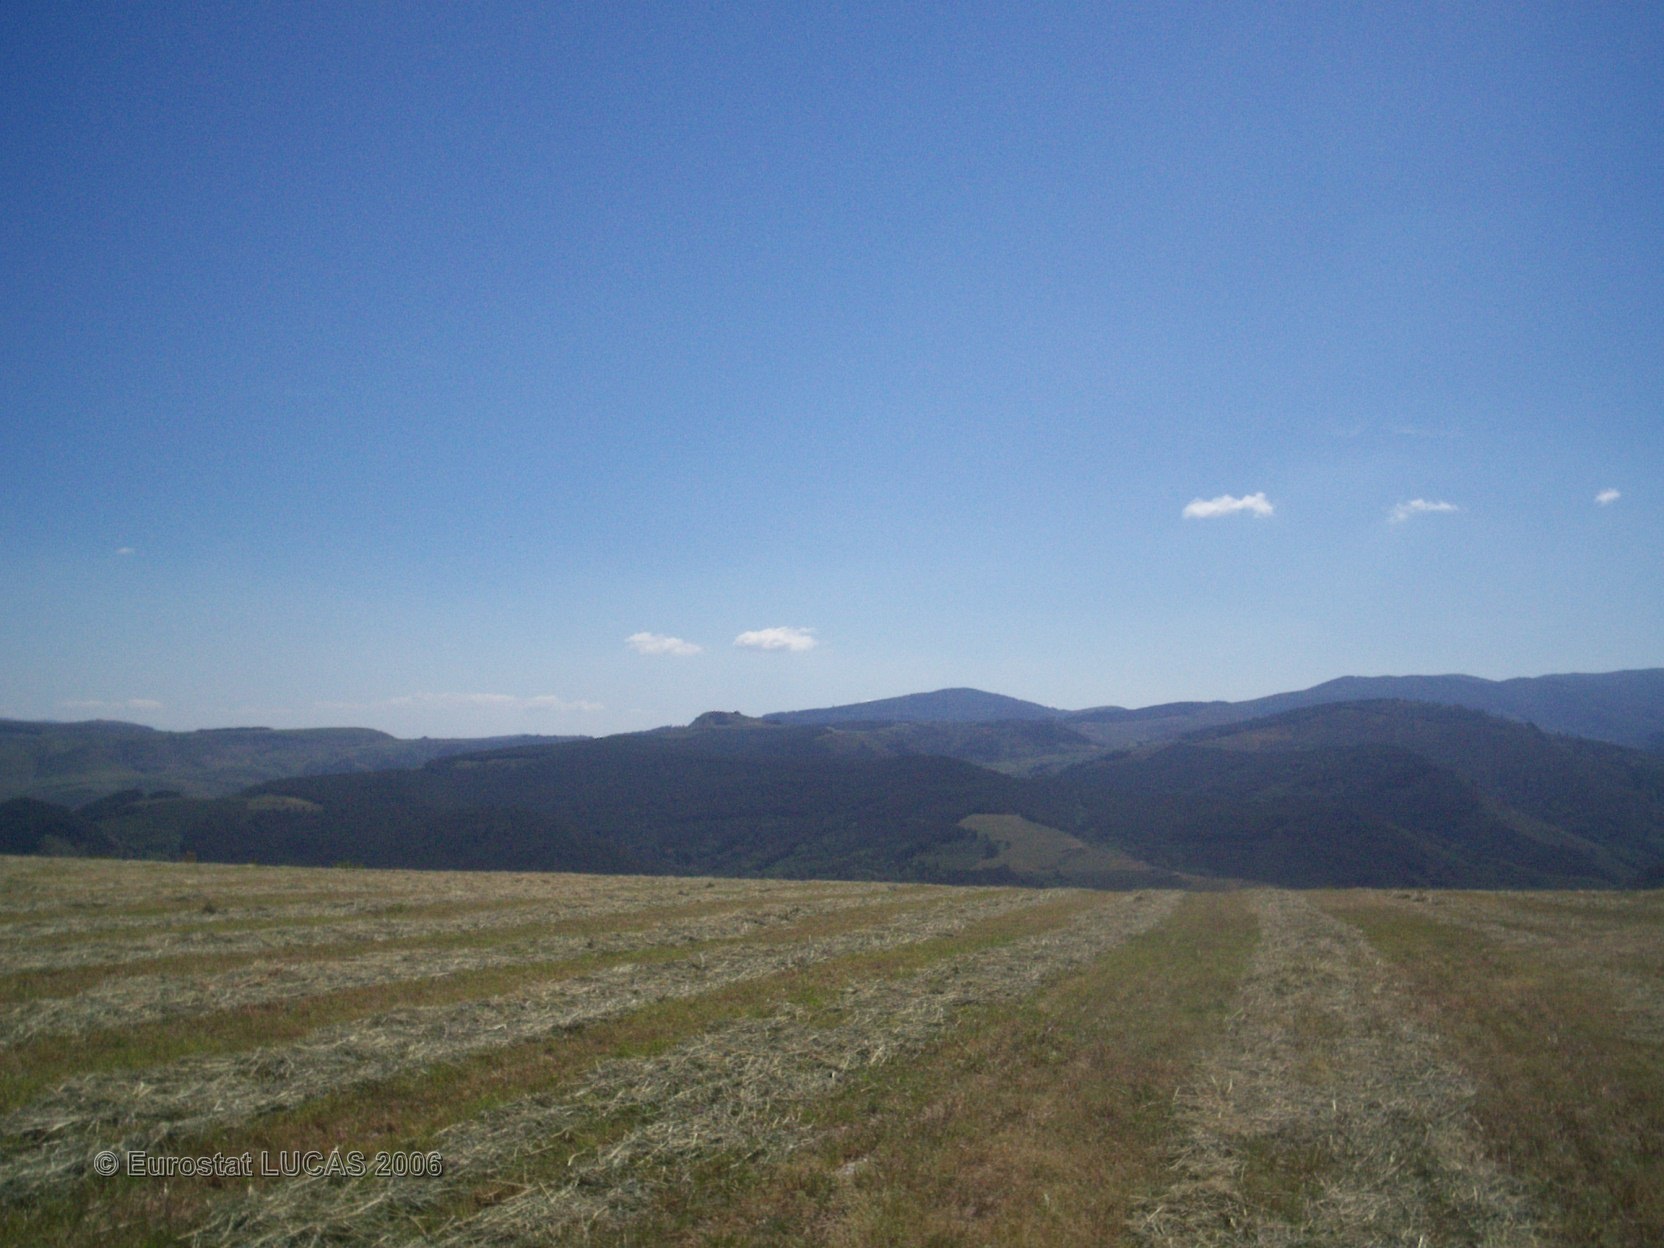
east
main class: Cropland
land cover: Other leguminous and mixtures for fodder
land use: Agriculture (excluding fallow land and kitchen gardens)
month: June
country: FR
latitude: 44.1775
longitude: 3.4145
